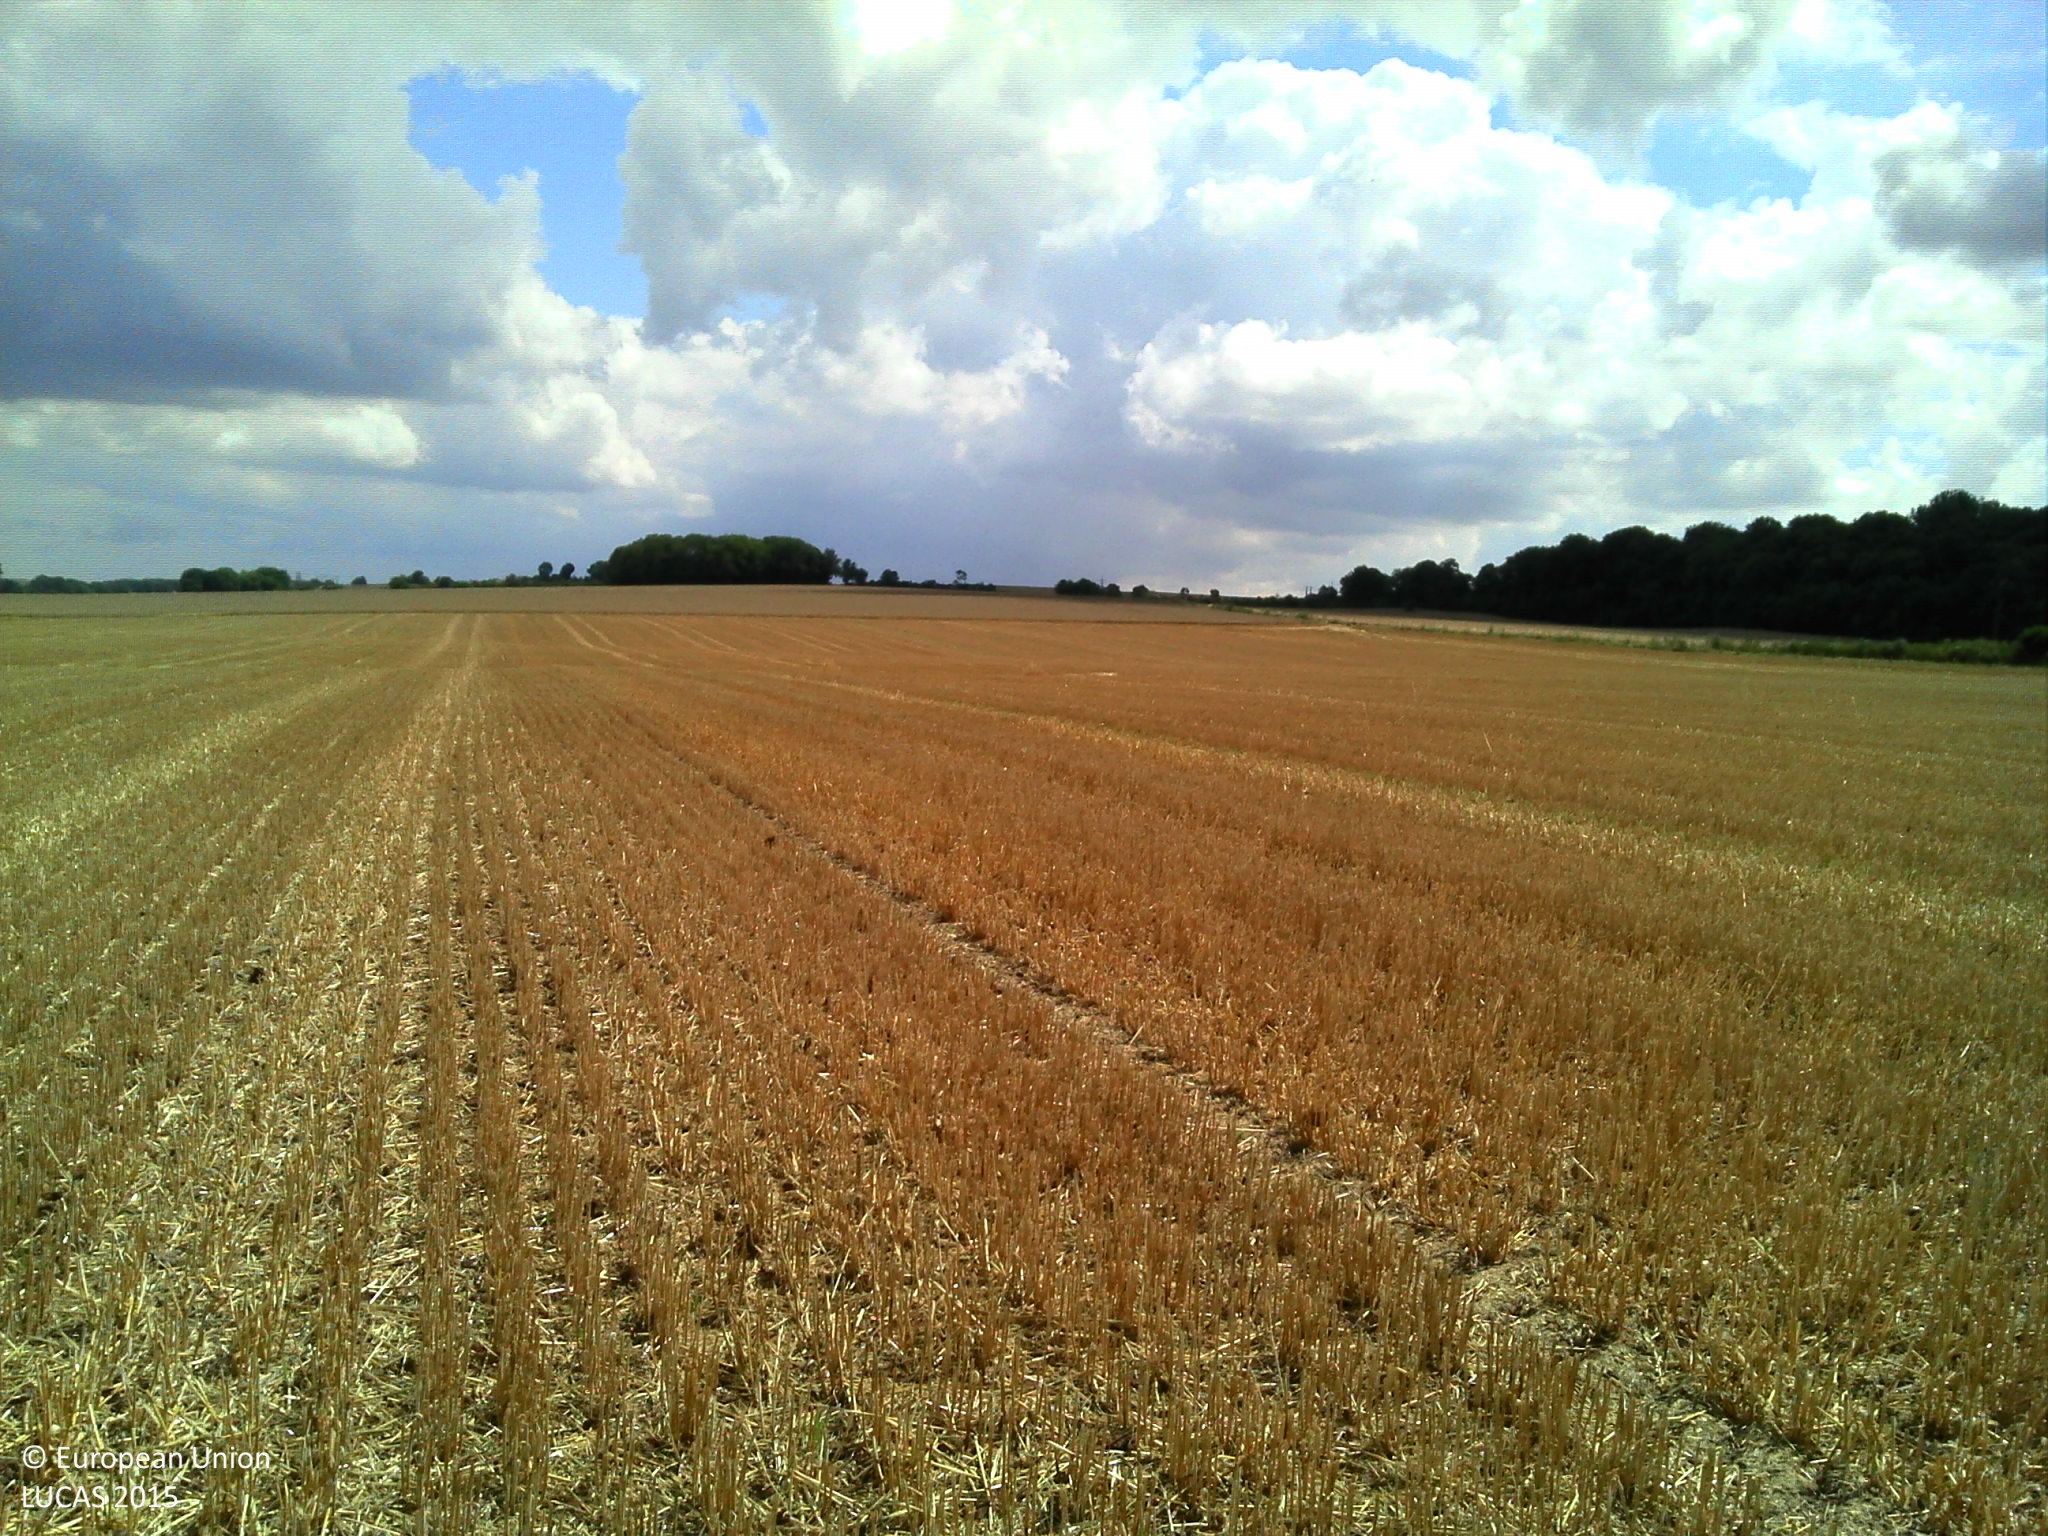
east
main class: Cropland
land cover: Barley
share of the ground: > 75 %
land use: Agriculture (excluding fallow land and kitchen gardens)
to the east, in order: Barley
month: July
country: FR
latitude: 50.0126
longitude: 2.5500
